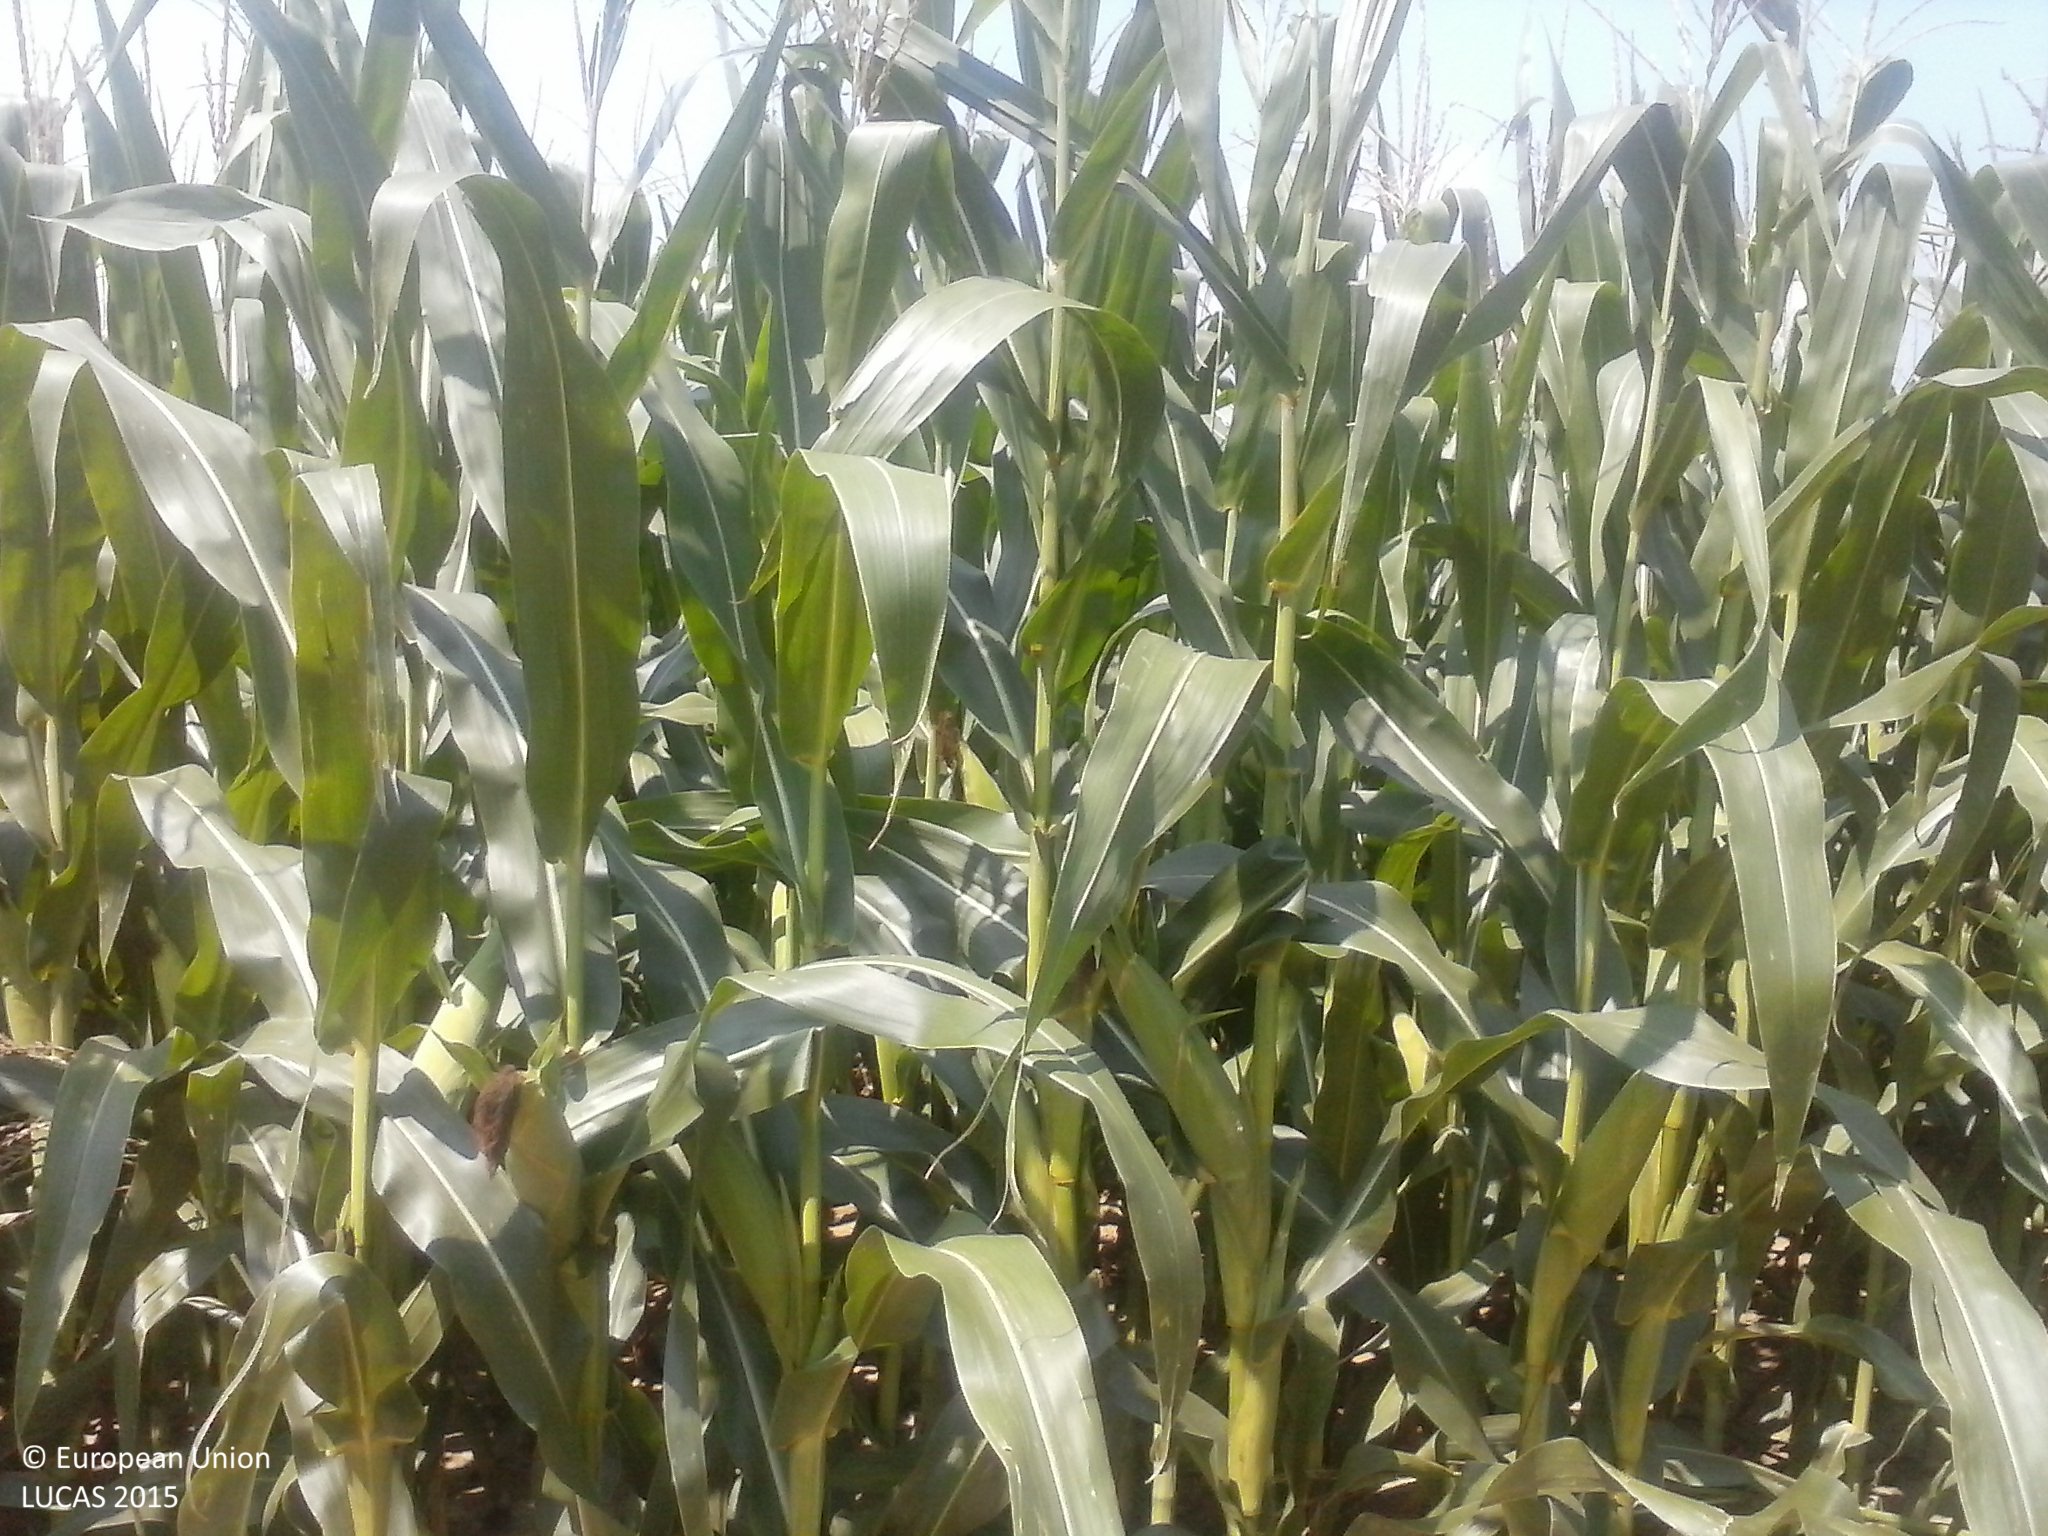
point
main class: Cropland
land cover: Maize
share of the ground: > 75 %
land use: Agriculture (excluding fallow land and kitchen gardens)
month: August
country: HU
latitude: 46.1697
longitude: 17.8675
